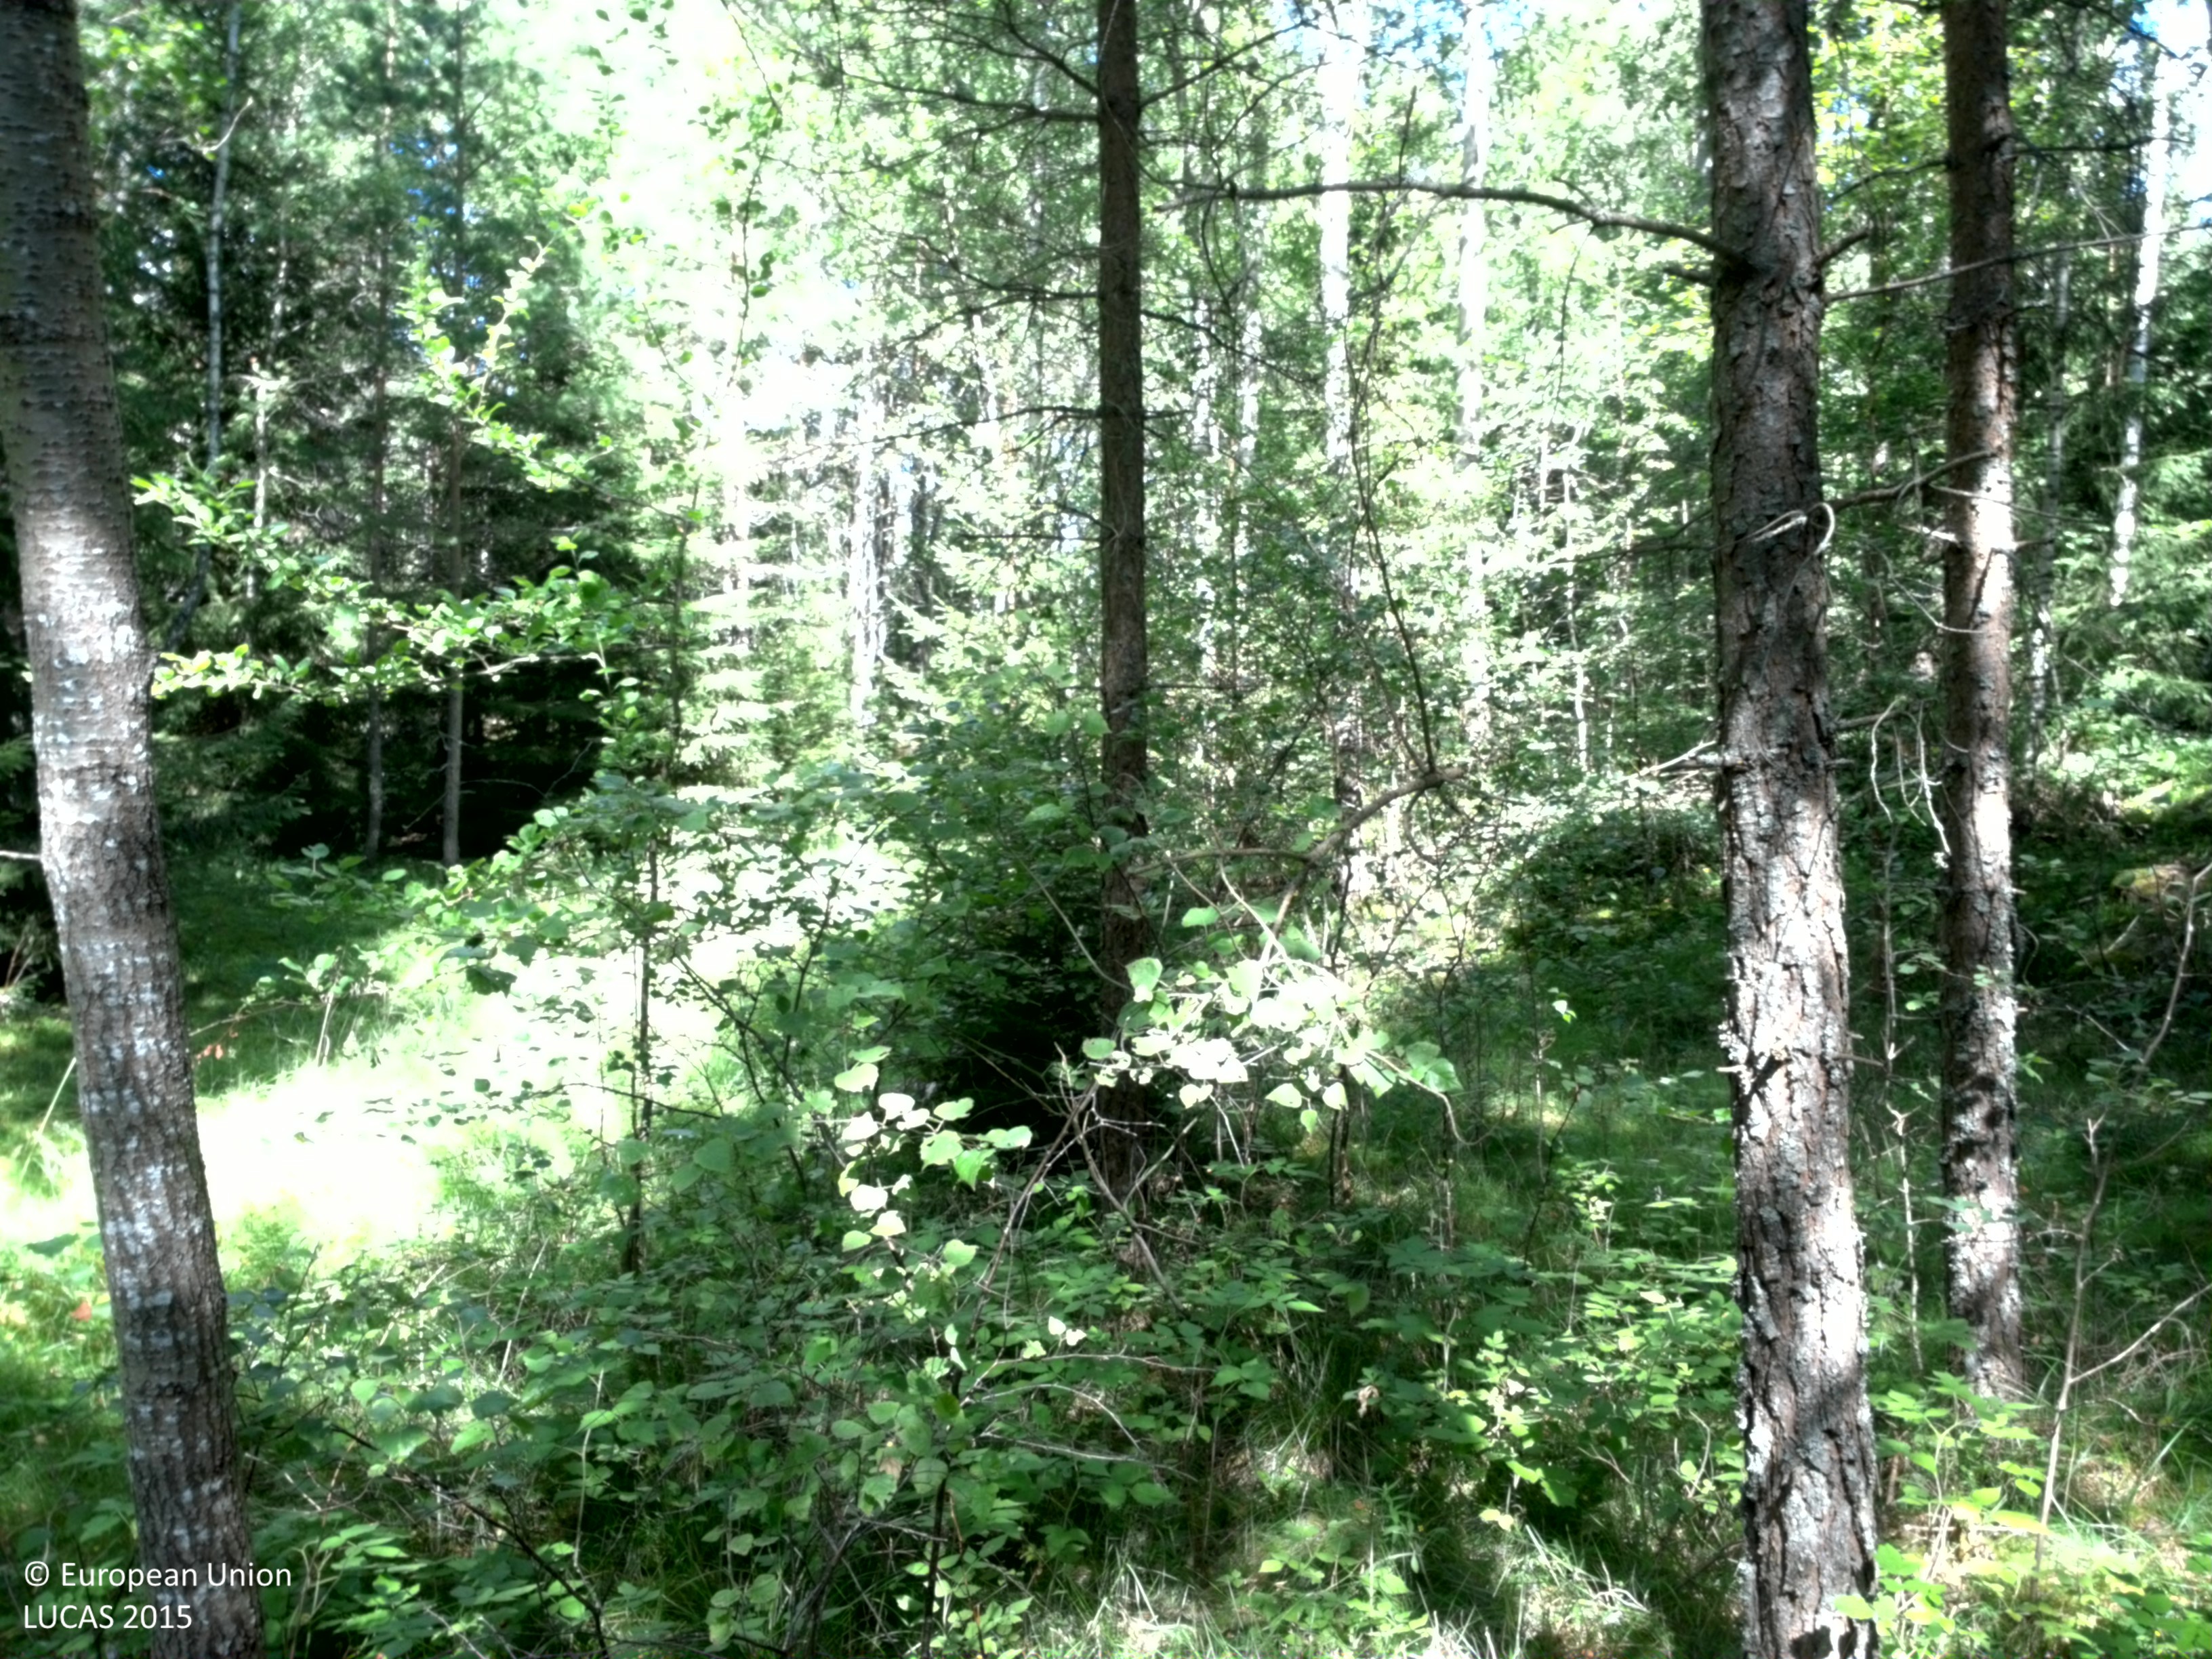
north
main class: Woodland
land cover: Pine dominated mixed woodland
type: boreal forest
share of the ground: 25 - 50 %
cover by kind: herbaceous plants 30 %, coniferous forest trees 25 %, broadleaved forest trees 25 %, lichens and mosses 15 %, shrubs 5 %
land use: Forestry
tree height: > 5 m
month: August
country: SE
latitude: 58.2351
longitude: 13.2134
